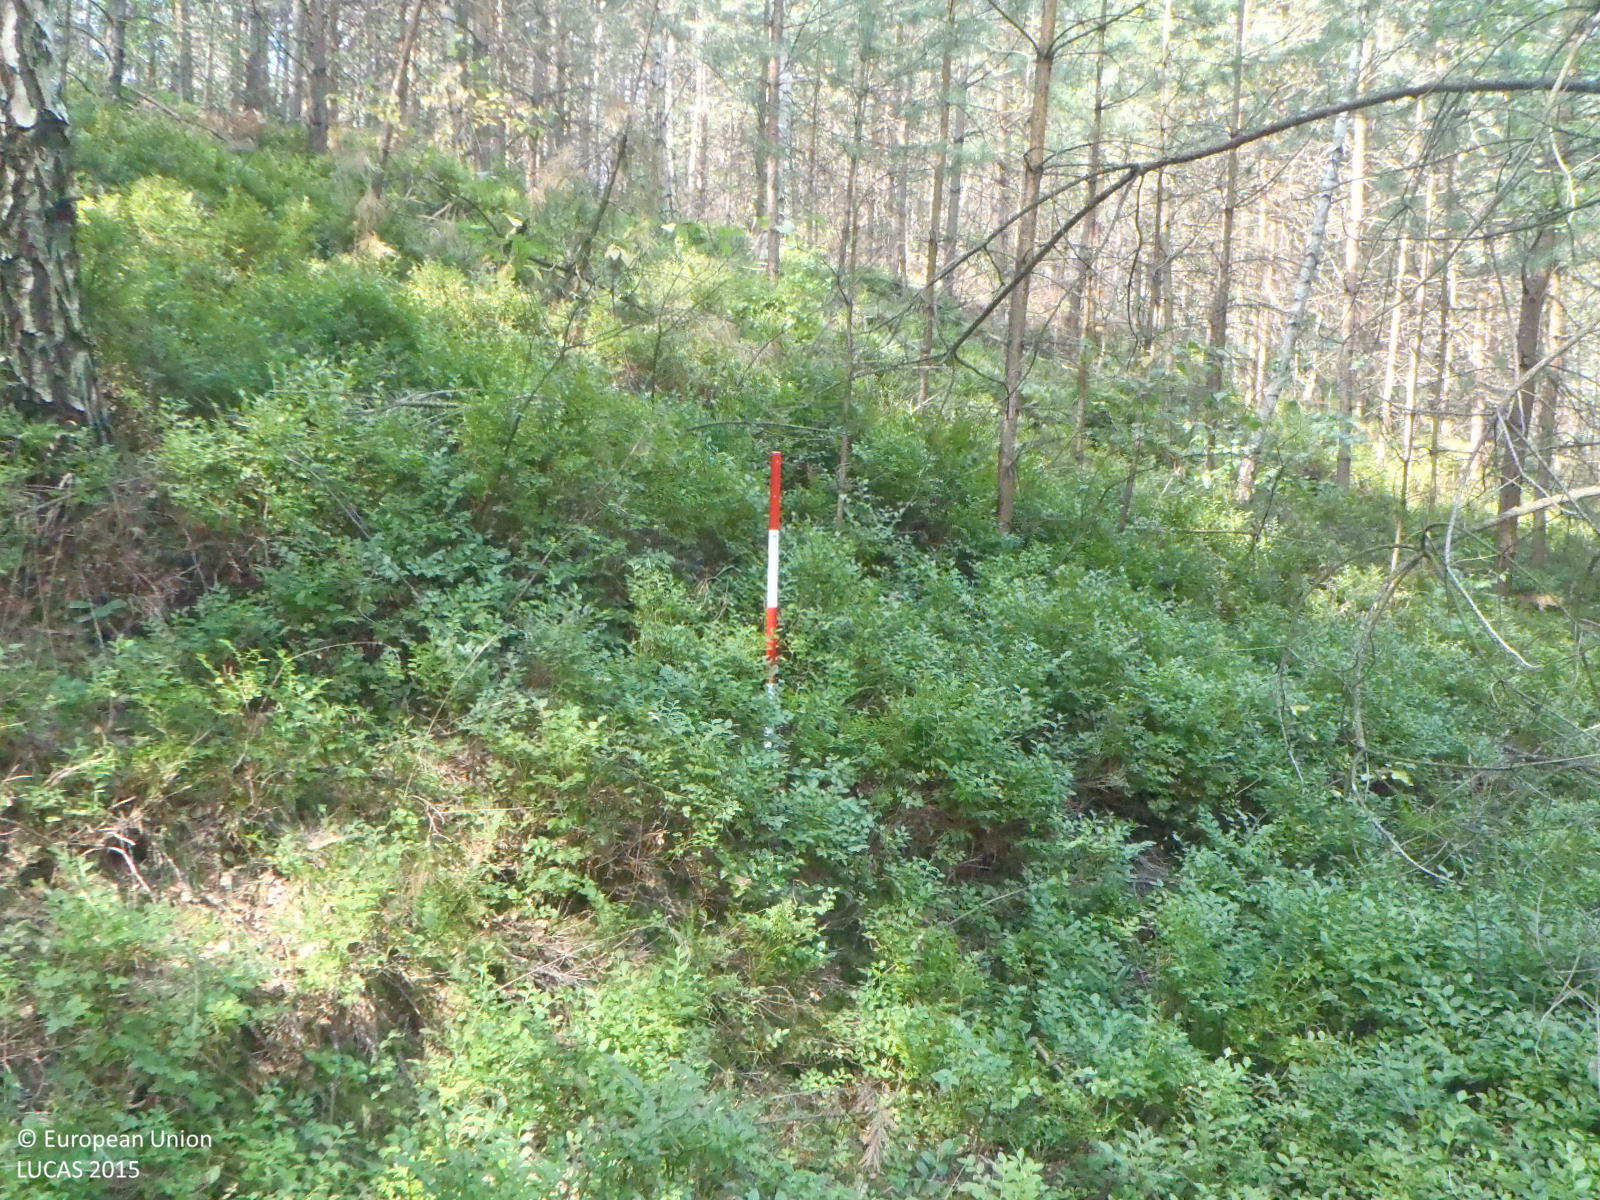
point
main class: Woodland
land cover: Pine dominated coniferous woodland
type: hemiboreal forest and nemoral coniferous forest and mixed broadleaved-coniferous forest
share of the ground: > 75 %
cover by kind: coniferous forest trees 85 %, broadleaved forest trees 10 %, herbaceous plants 5 %
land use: Forestry
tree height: > 5 m
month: August
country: CZ
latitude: 50.6510
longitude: 14.5703
